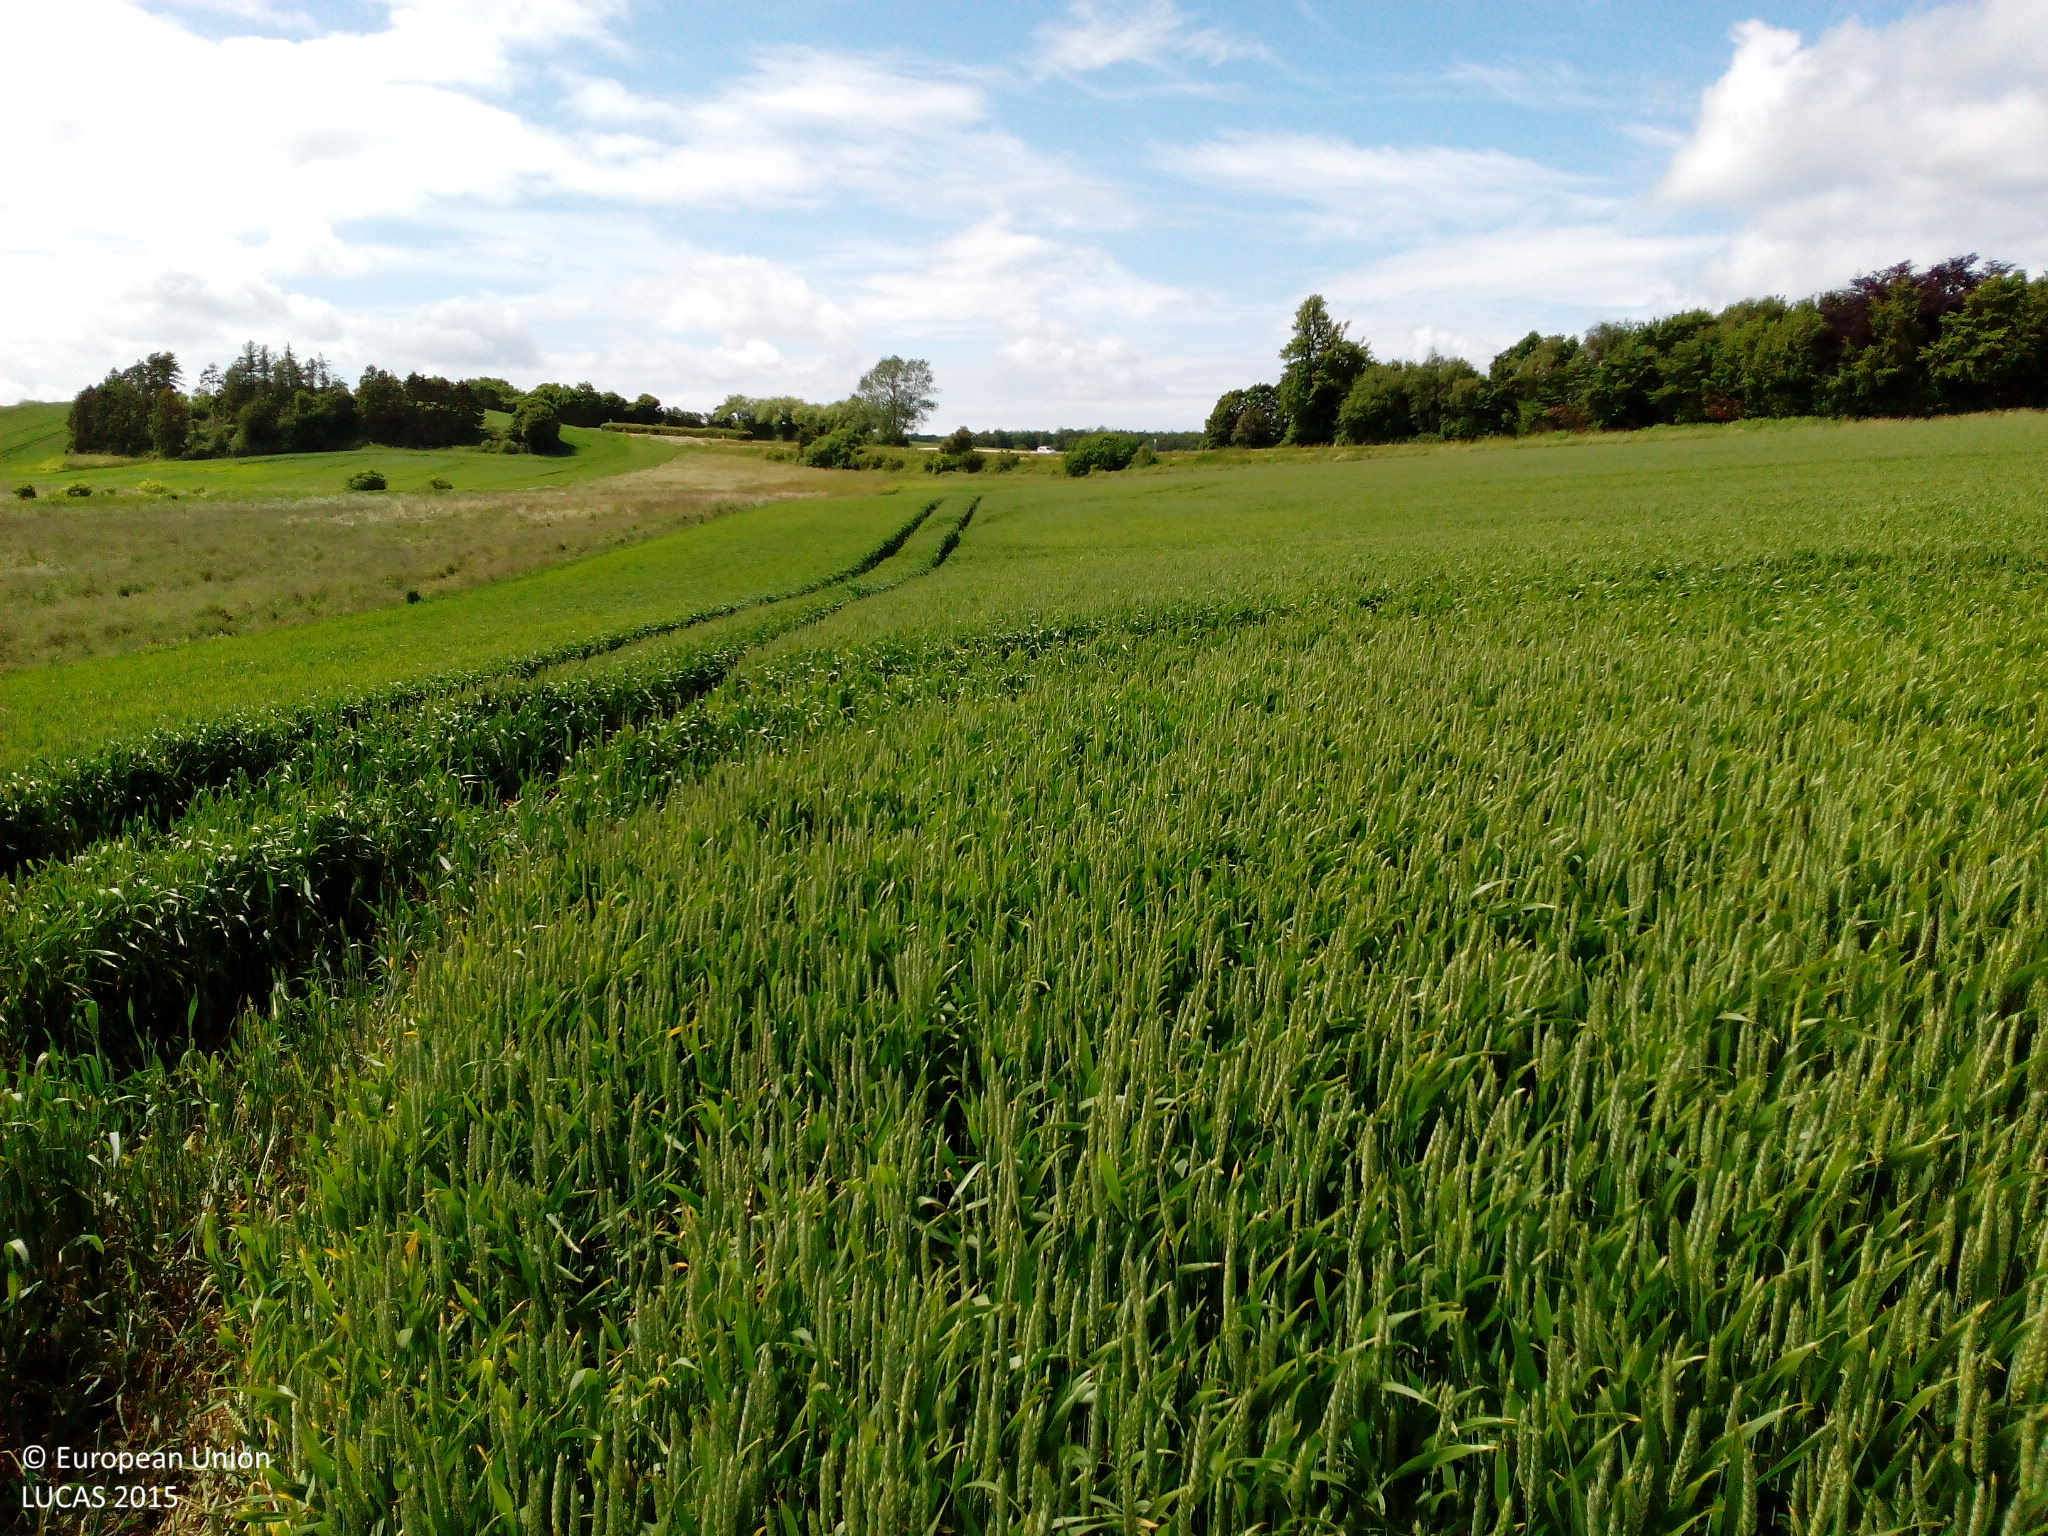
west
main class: Cropland
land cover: Common wheat
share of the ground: > 75 %
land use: Agriculture (excluding fallow land and kitchen gardens)
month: June
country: DK
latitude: 54.9807
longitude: 10.8275
